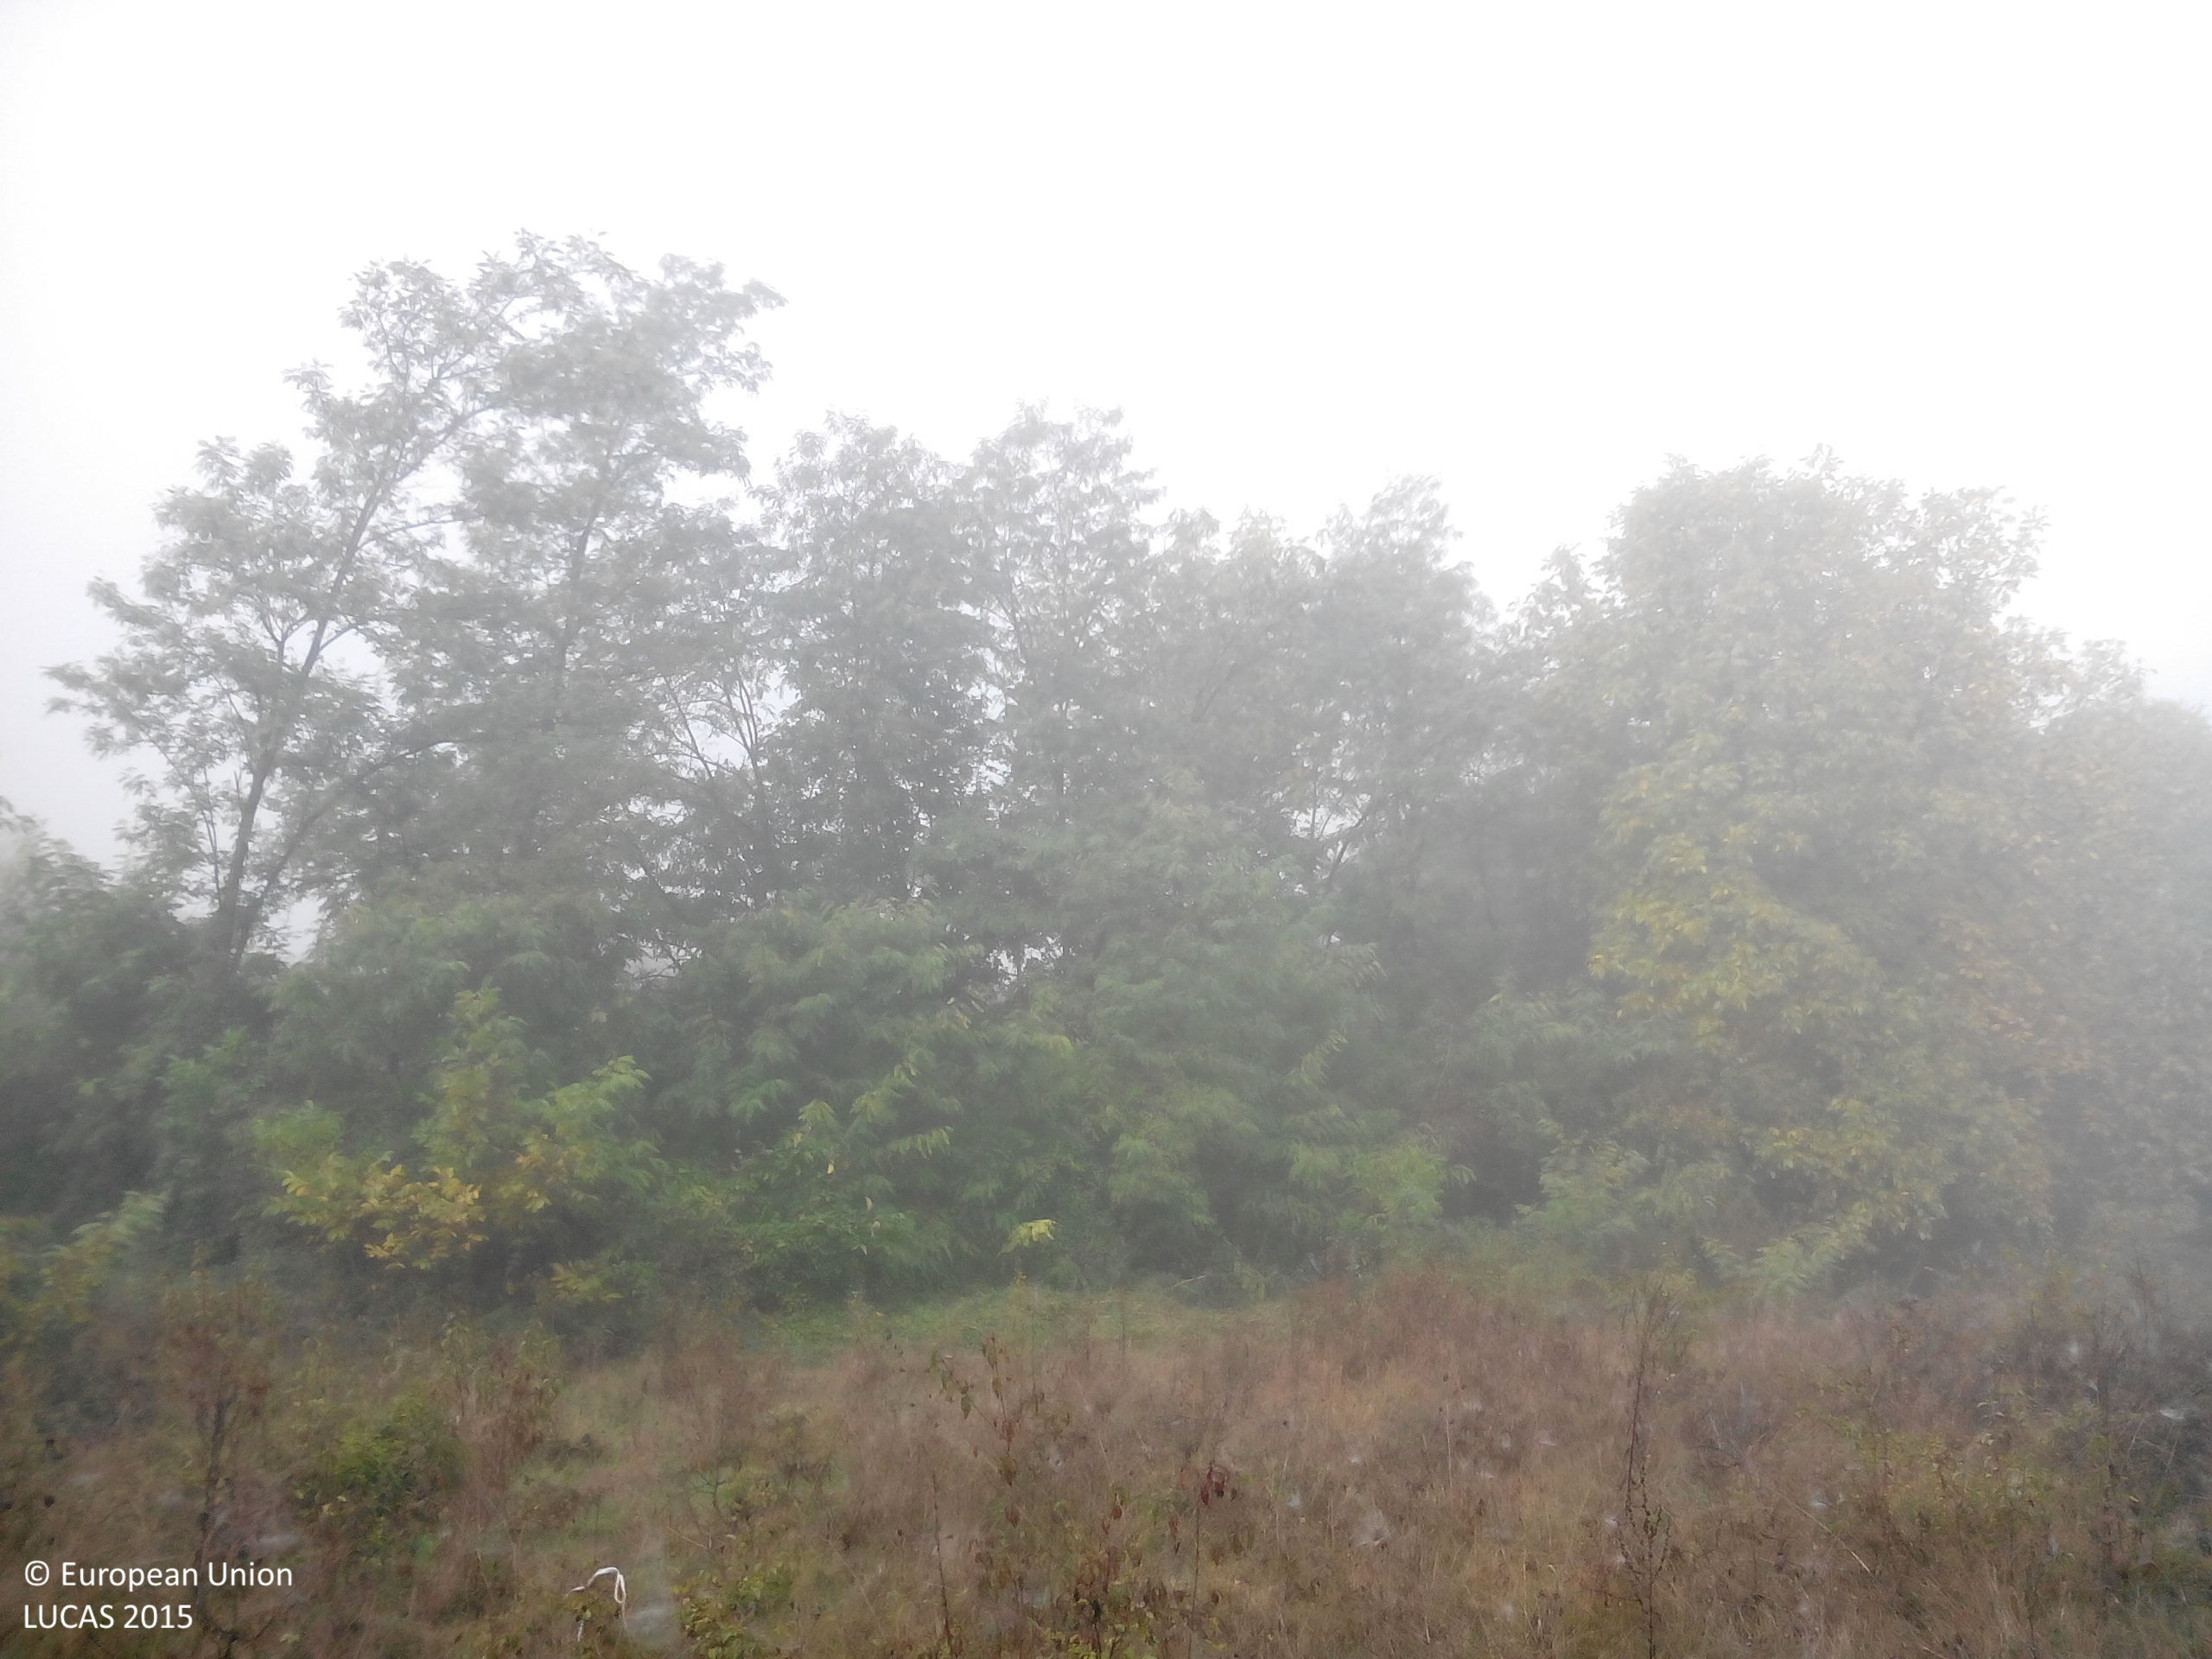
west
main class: Woodland
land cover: Broadleaved woodland
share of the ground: 50 - 75 %
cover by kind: shrubs 50 %, herbaceous plants 30 %, broadleaved forest trees 20 %
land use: Abandoned areas
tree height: > 5 m
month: October
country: BG
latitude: 42.9634
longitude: 24.0860
